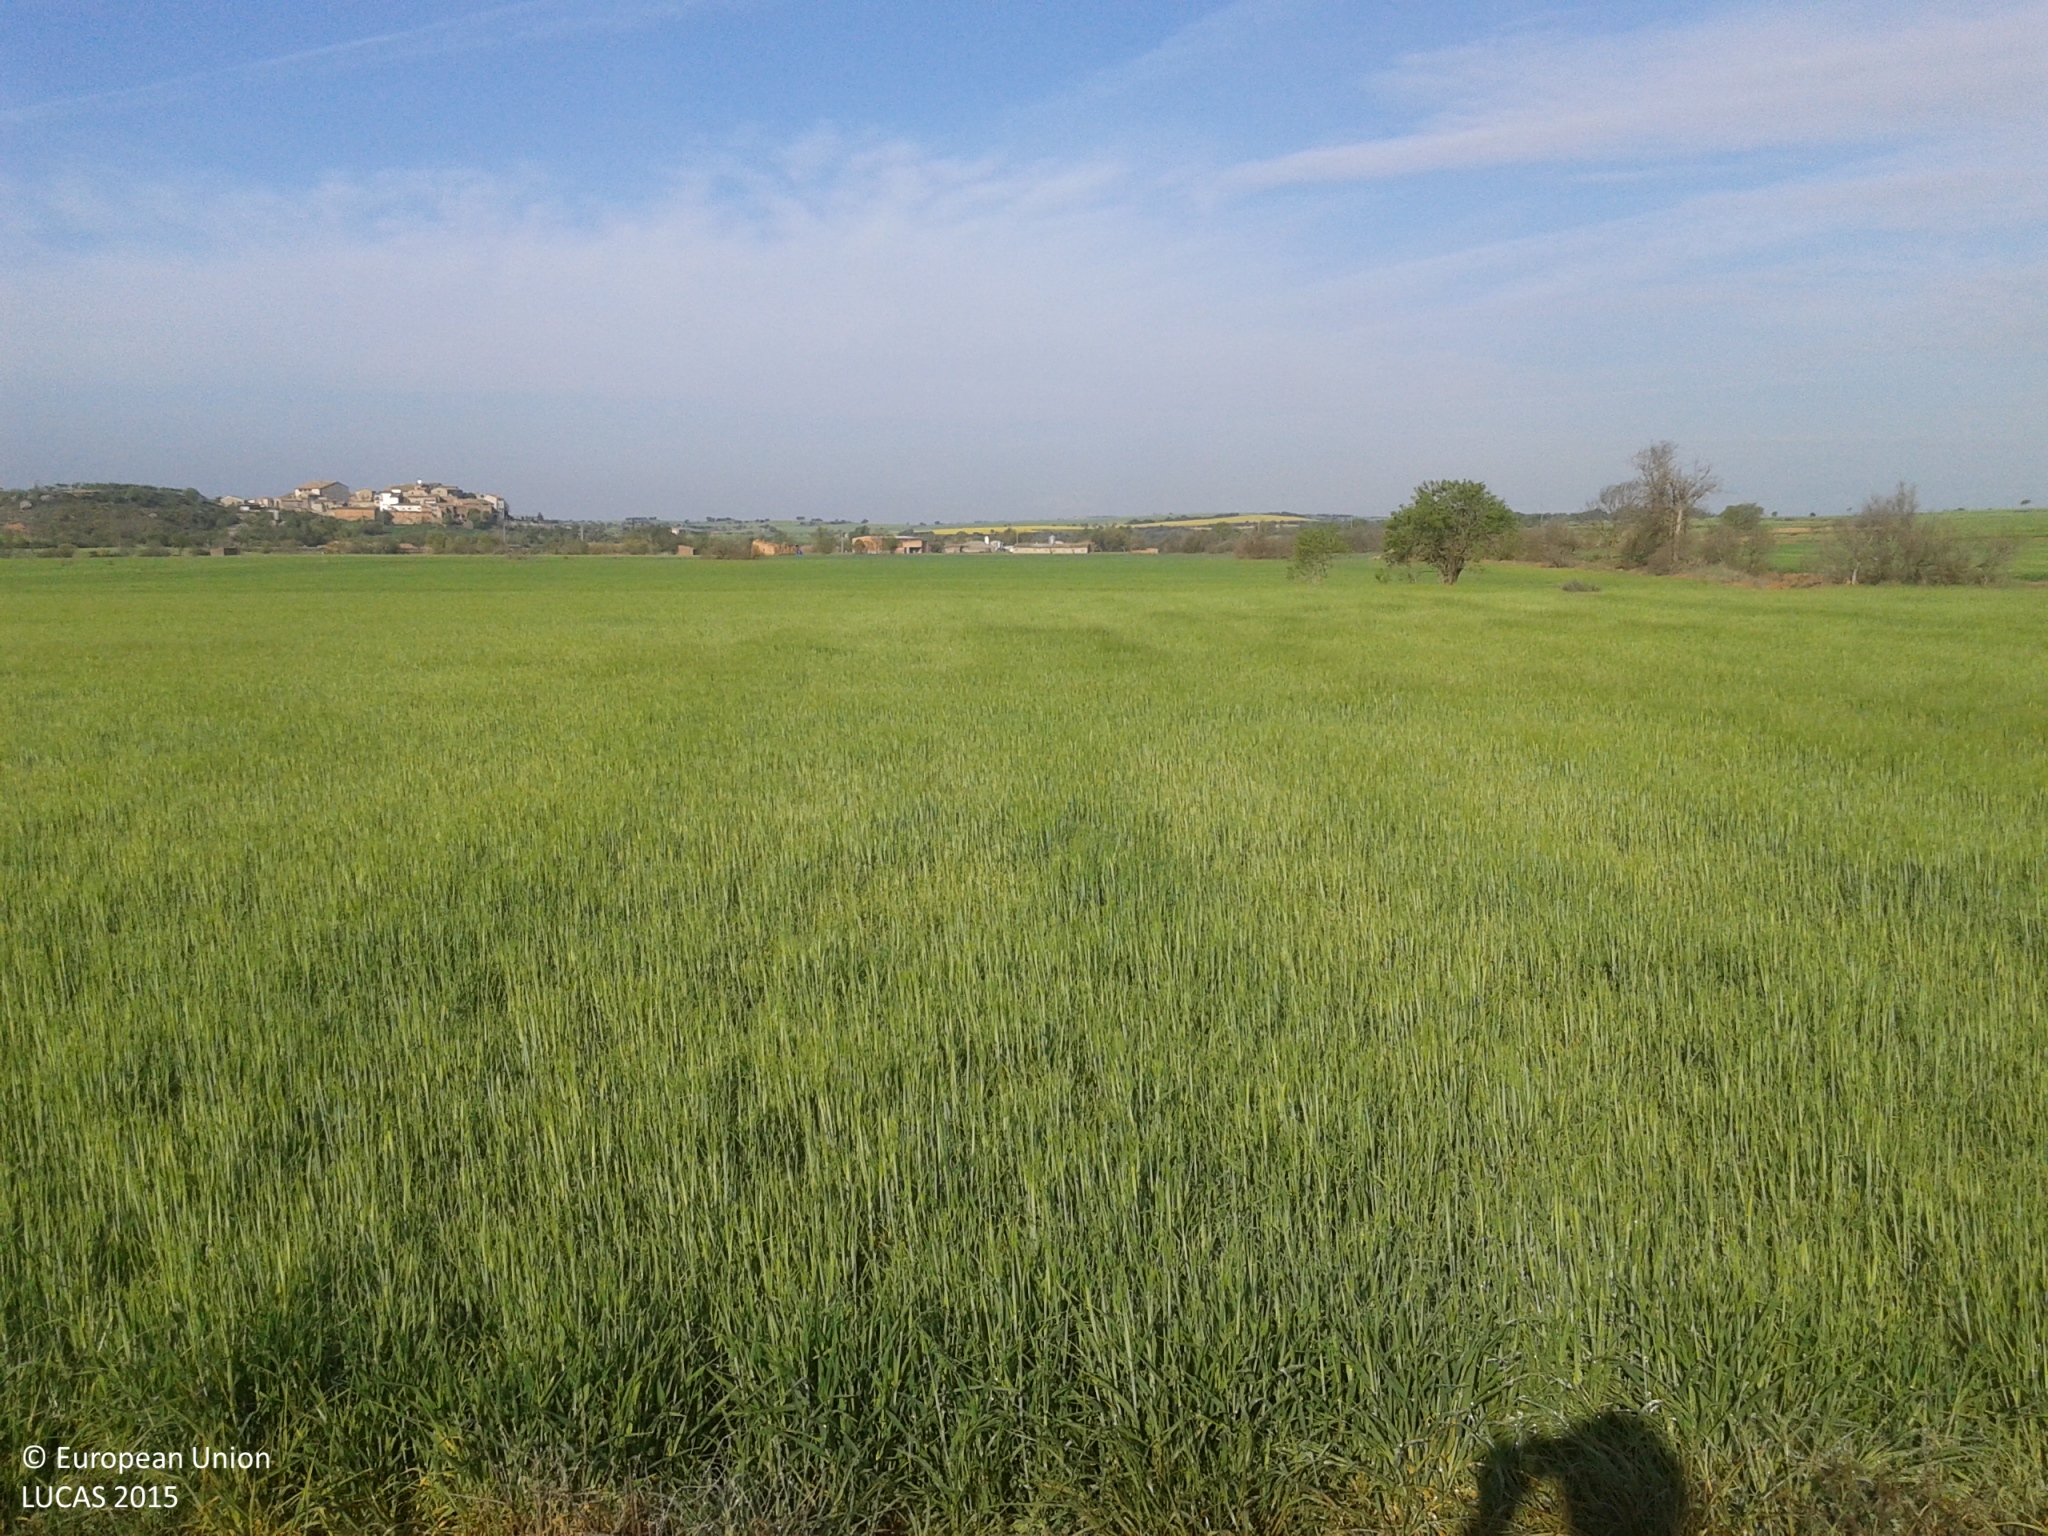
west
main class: Cropland
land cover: Barley
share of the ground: > 75 %
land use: Agriculture (excluding fallow land and kitchen gardens)
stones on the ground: 10 - 25 %
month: April
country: ES
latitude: 41.7595
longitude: 1.1726
